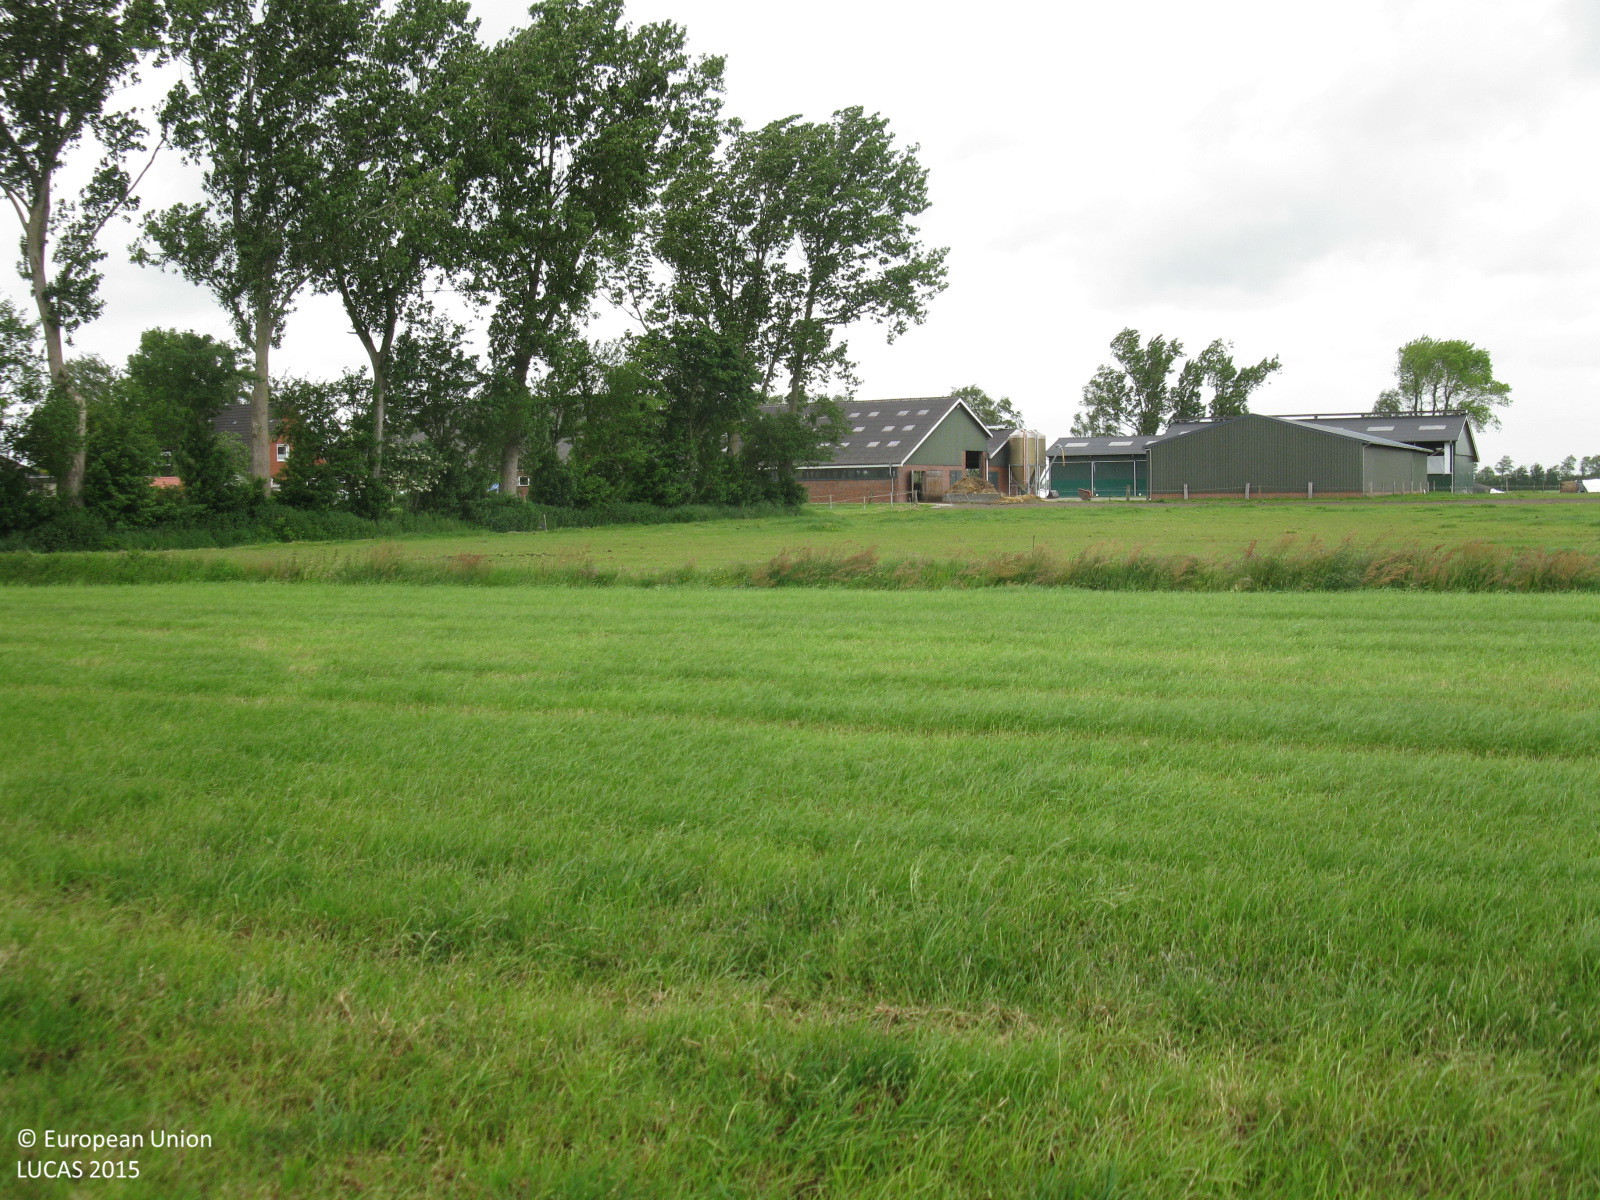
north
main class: Grassland
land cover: Grassland without tree/shrub cover
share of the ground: > 75 %
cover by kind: herbaceous plants 100 %
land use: Agriculture (excluding fallow land and kitchen gardens)
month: June
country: DE
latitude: 53.1406
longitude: 7.4143
